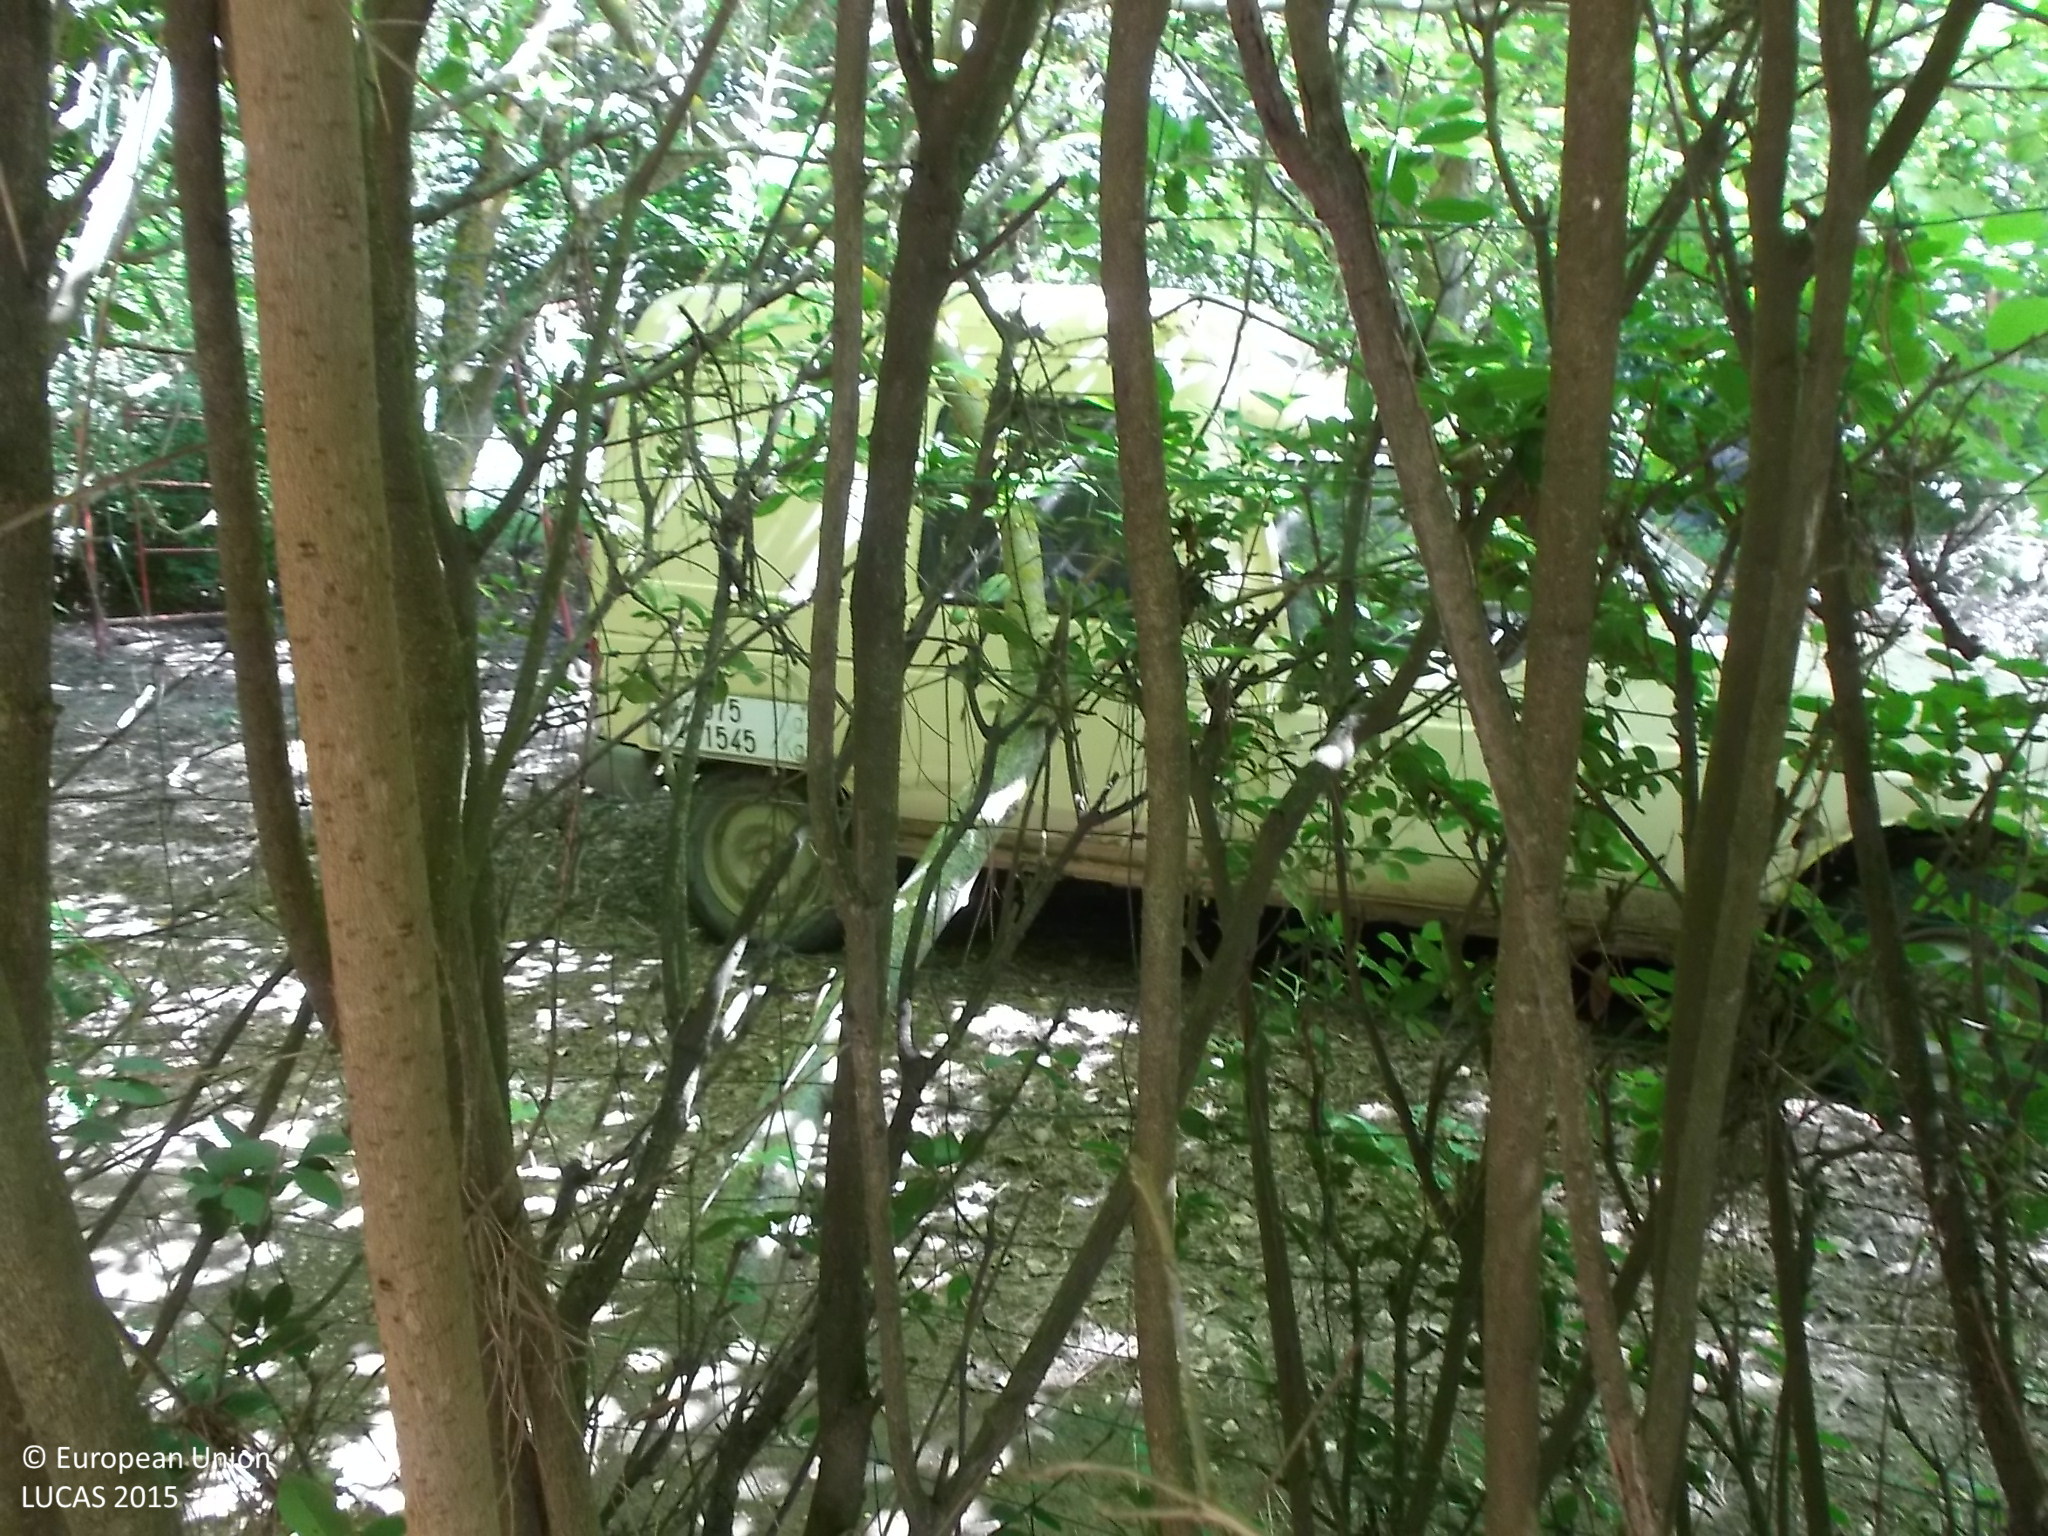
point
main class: Woodland
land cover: Broadleaved woodland
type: broadleaved evergreen forest
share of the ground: > 75 %
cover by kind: broadleaved forest trees 80 %, herbaceous plants 20 %
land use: Residential
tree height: < 5 m
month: July
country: ES
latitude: 41.4904
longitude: -5.3745
